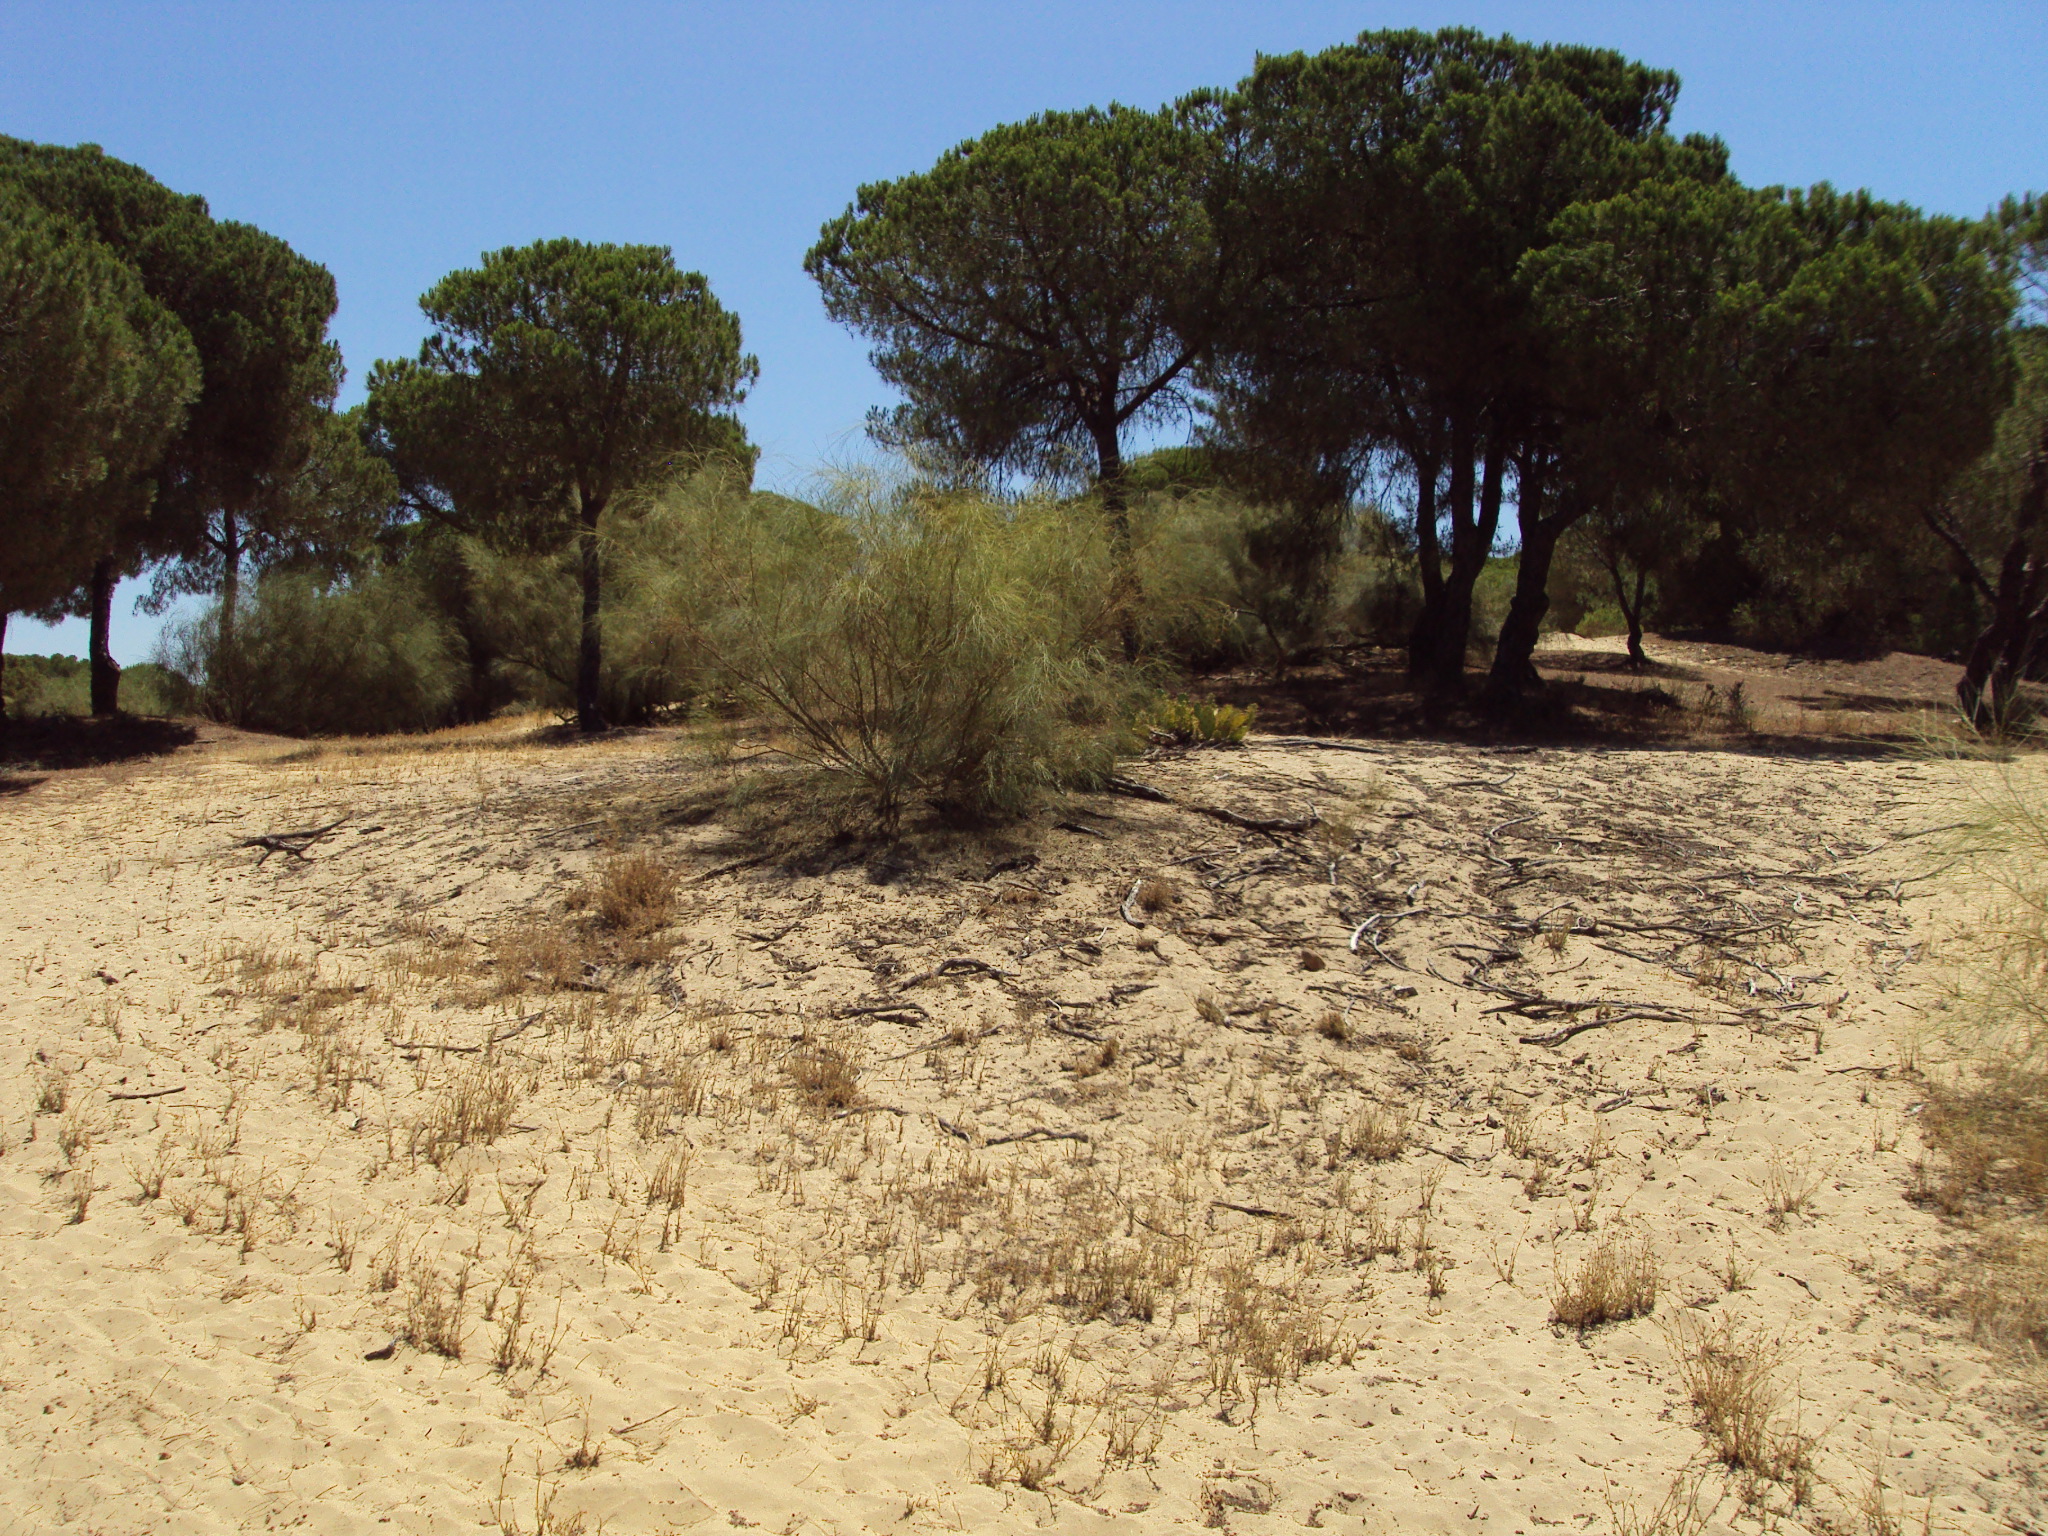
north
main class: Shrubland
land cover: Shrubland without tree cover
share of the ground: 50 - 75 %
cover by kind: shrubs 60 %, herbaceous plants 20 %, unconsolidated bare surface 20 %
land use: Semi-natural and natural areas not in use
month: July
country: ES
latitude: 37.2130
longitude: -7.0434
